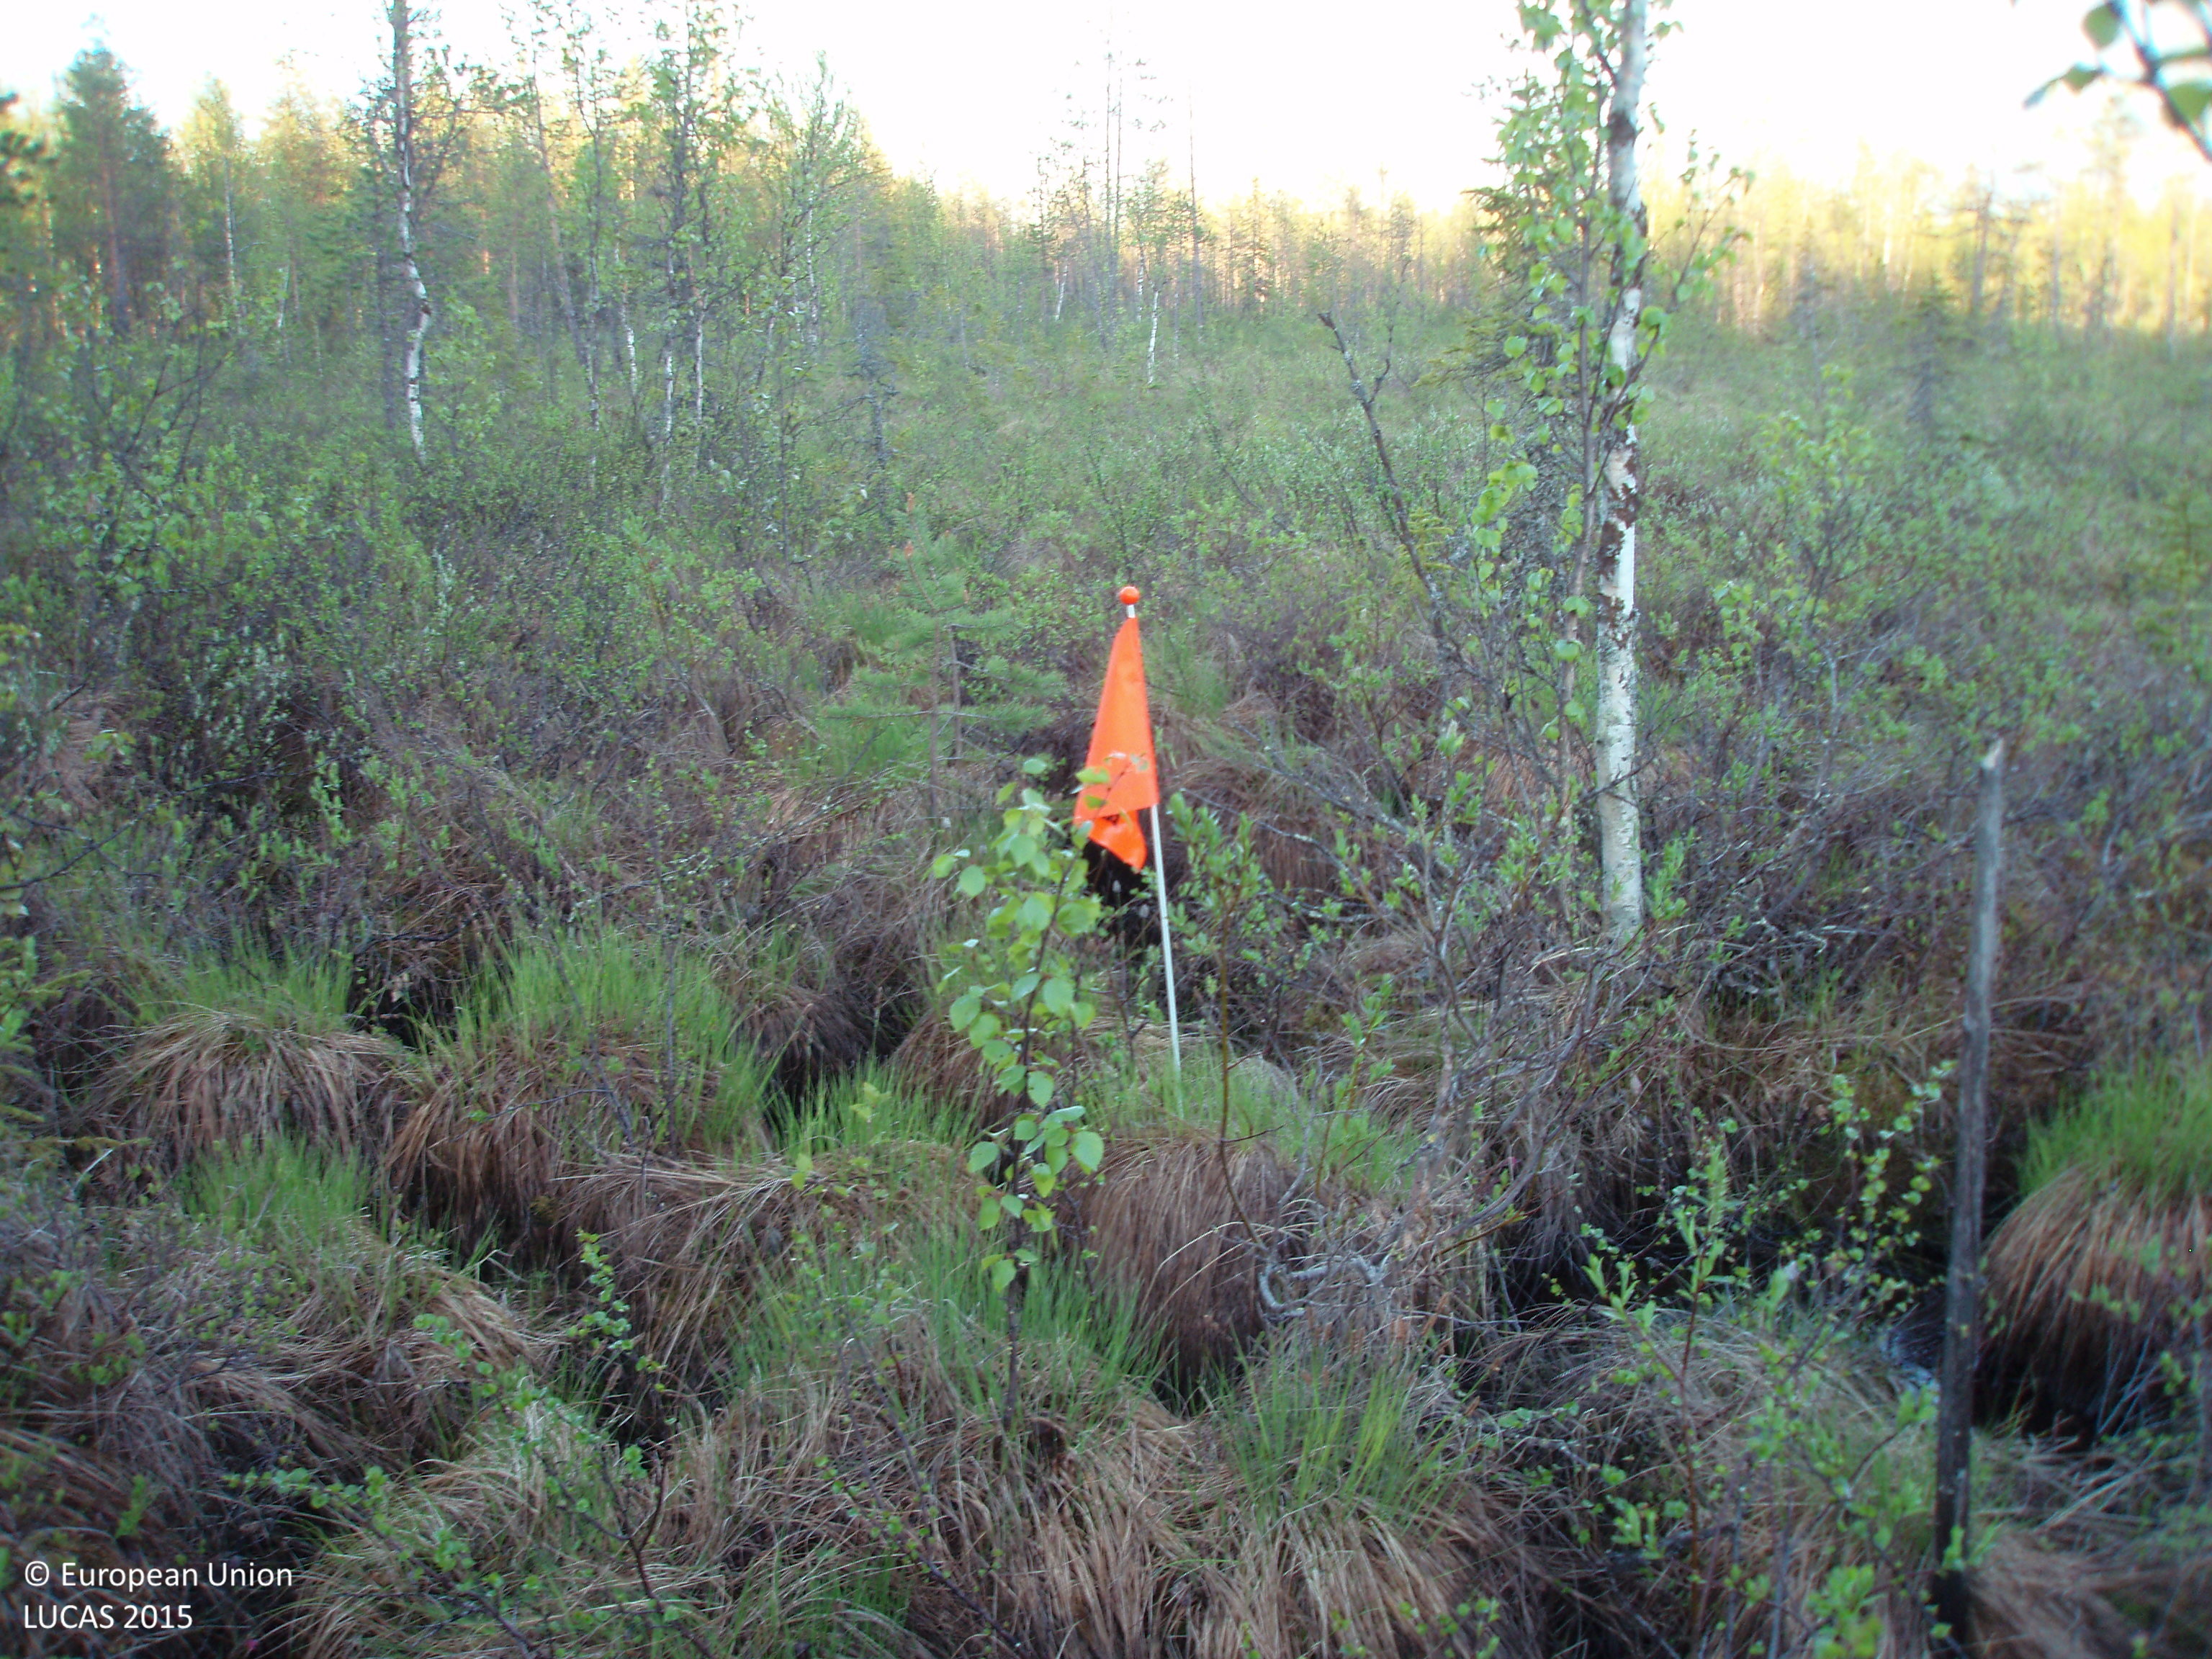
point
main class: Woodland
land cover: Broadleaved woodland
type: mire and swamp forests
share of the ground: 50 - 75 %
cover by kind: broadleaved forest trees 45 %, shrubs 25 %, herbaceous plants 20 %, coniferous forest trees 10 %
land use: Forestry
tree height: > 5 m
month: June
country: FI
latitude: 67.2158
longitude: 26.9565
